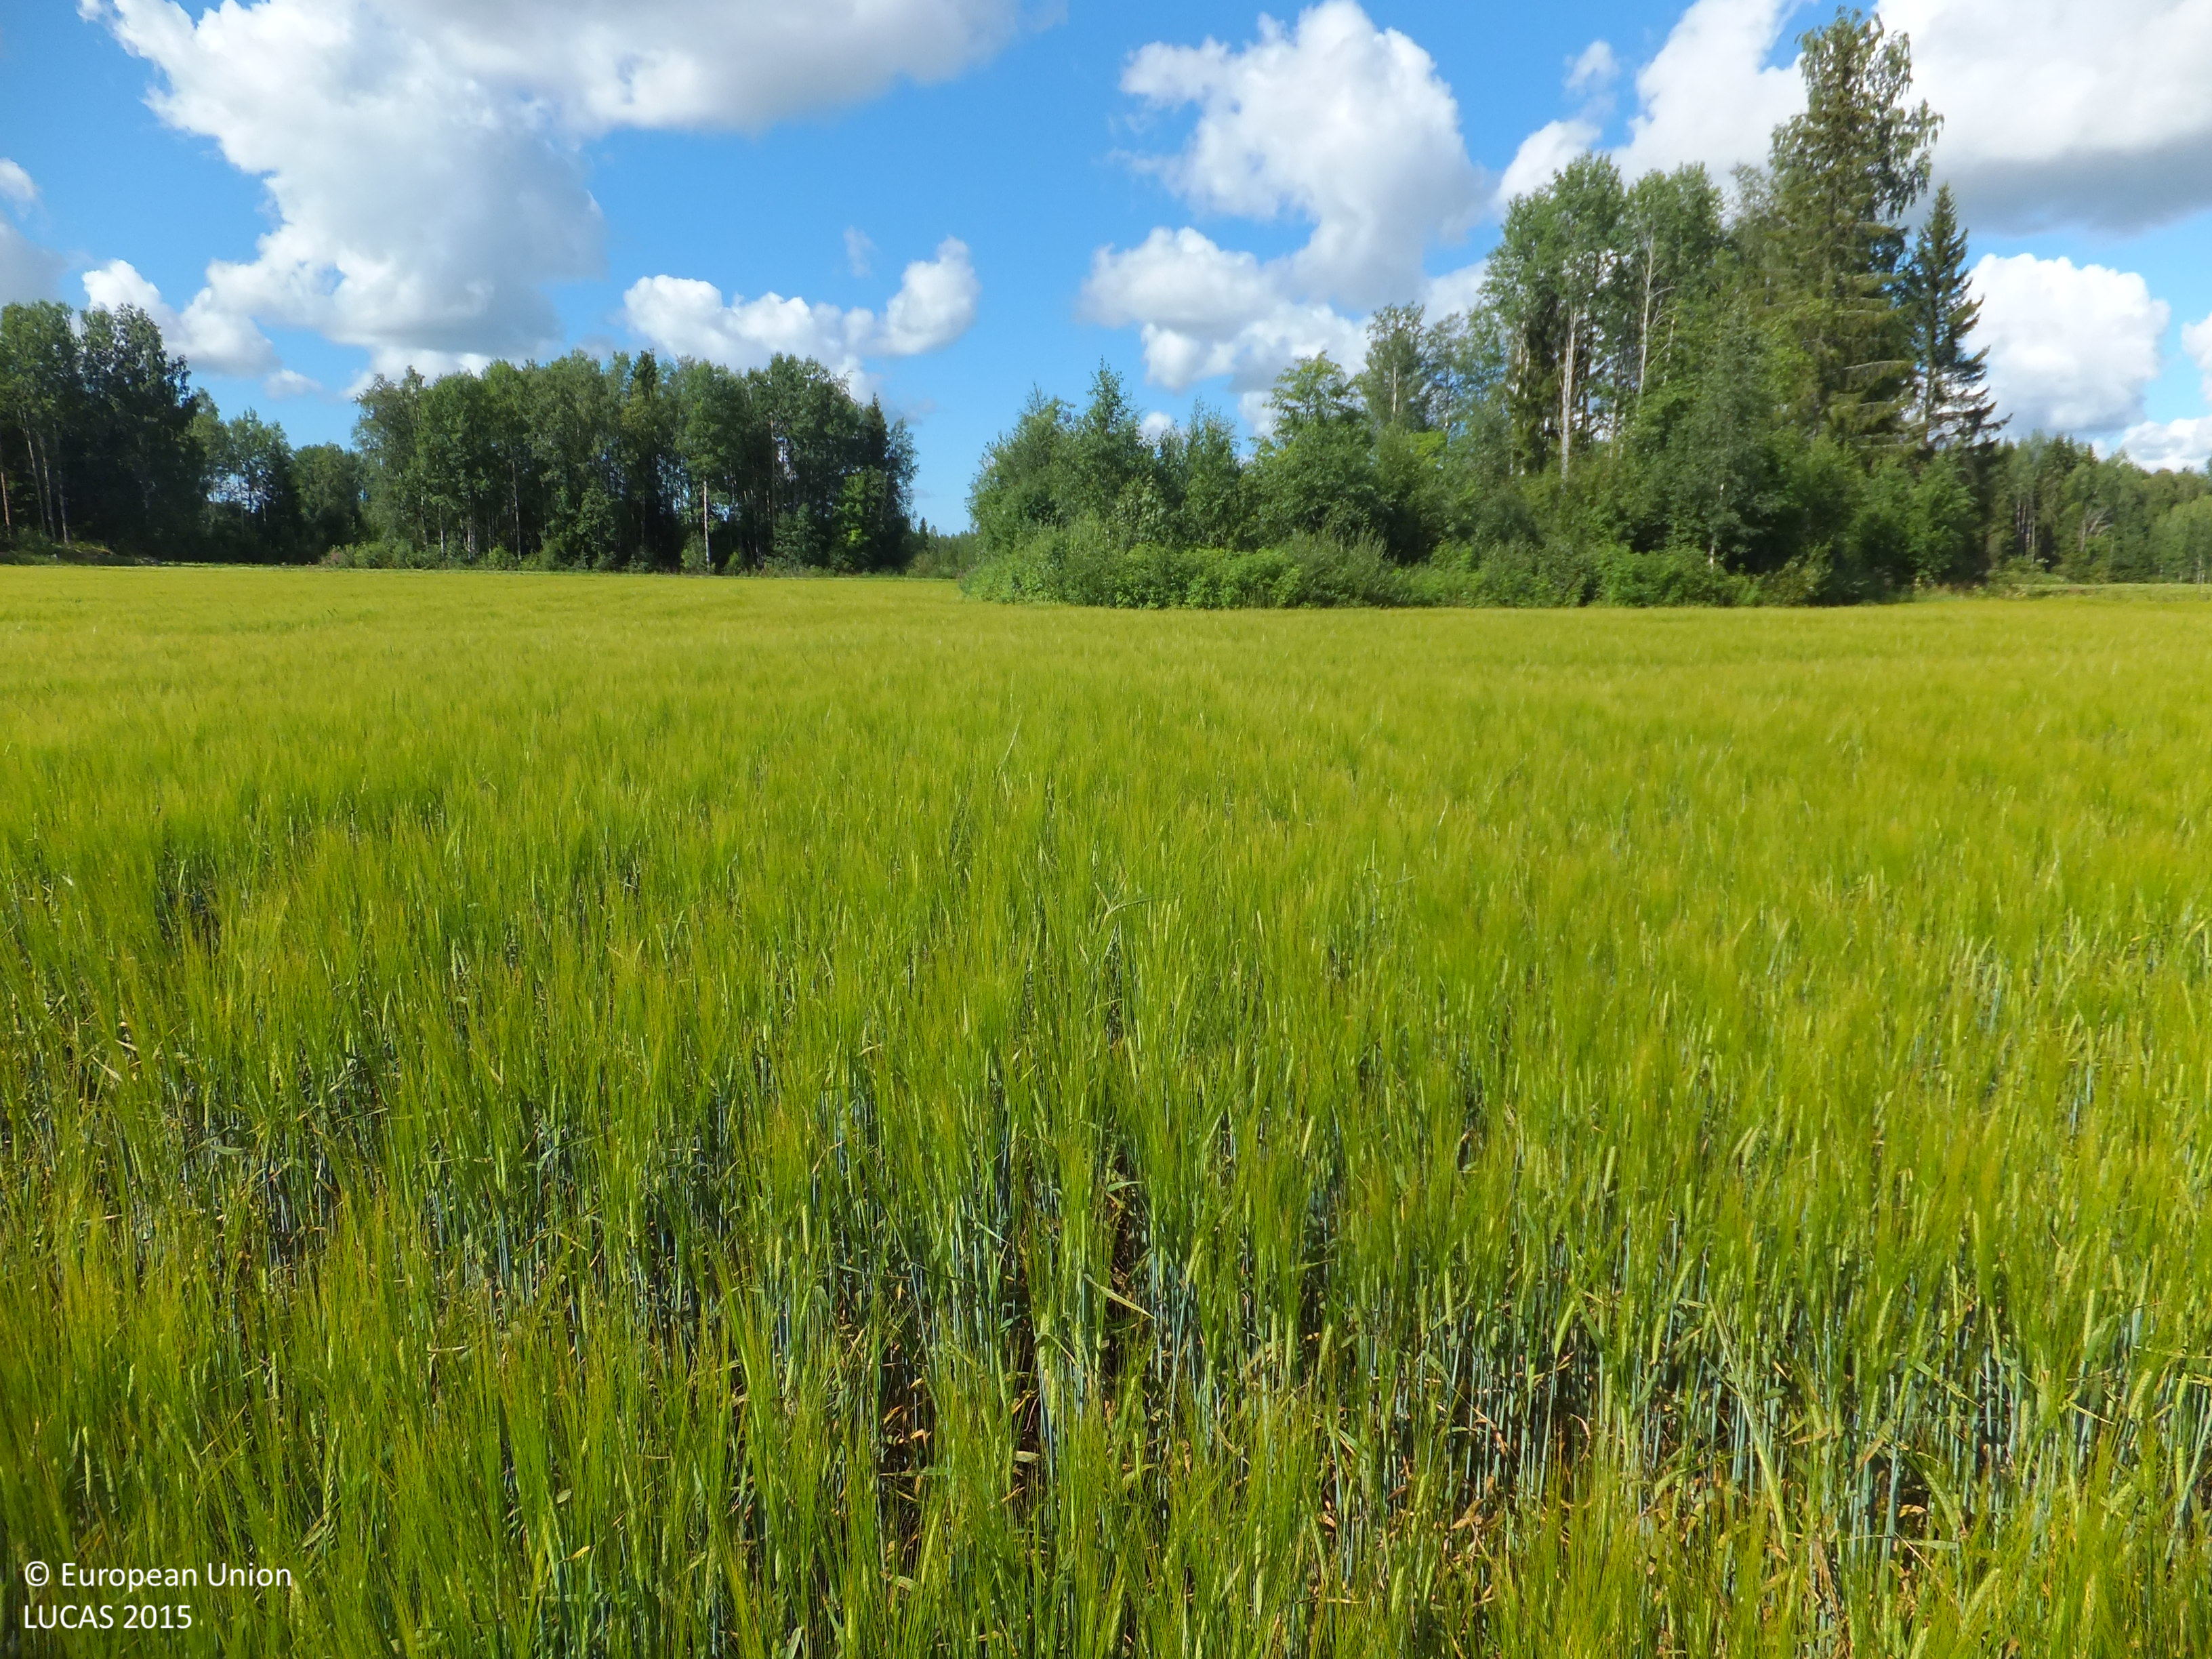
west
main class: Cropland
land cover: Barley
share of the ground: > 75 %
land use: Agriculture (excluding fallow land and kitchen gardens)
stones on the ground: < 10 %
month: August
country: FI
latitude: 63.0932
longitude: 22.7504
